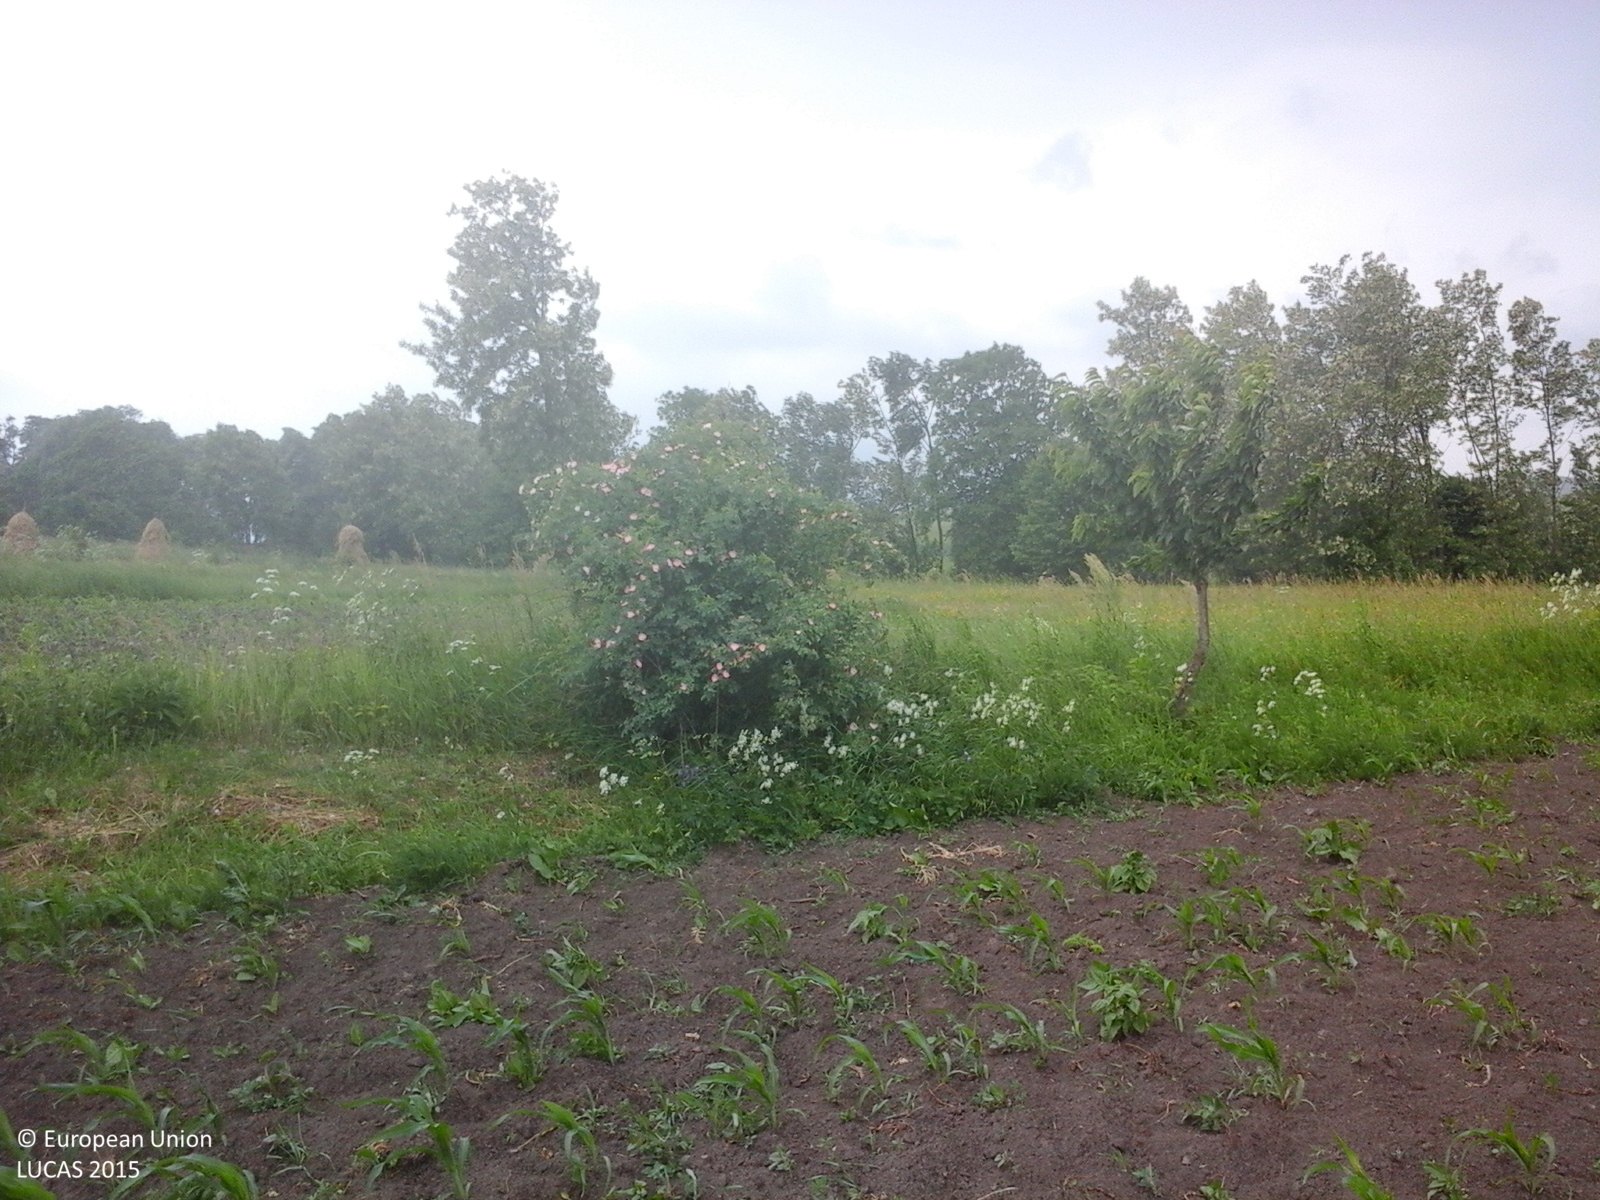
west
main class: Cropland
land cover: Maize
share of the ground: 10 - 25 %
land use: Agriculture (excluding fallow land and kitchen gardens)
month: June
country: RO
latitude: 47.1967
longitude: 26.3310
